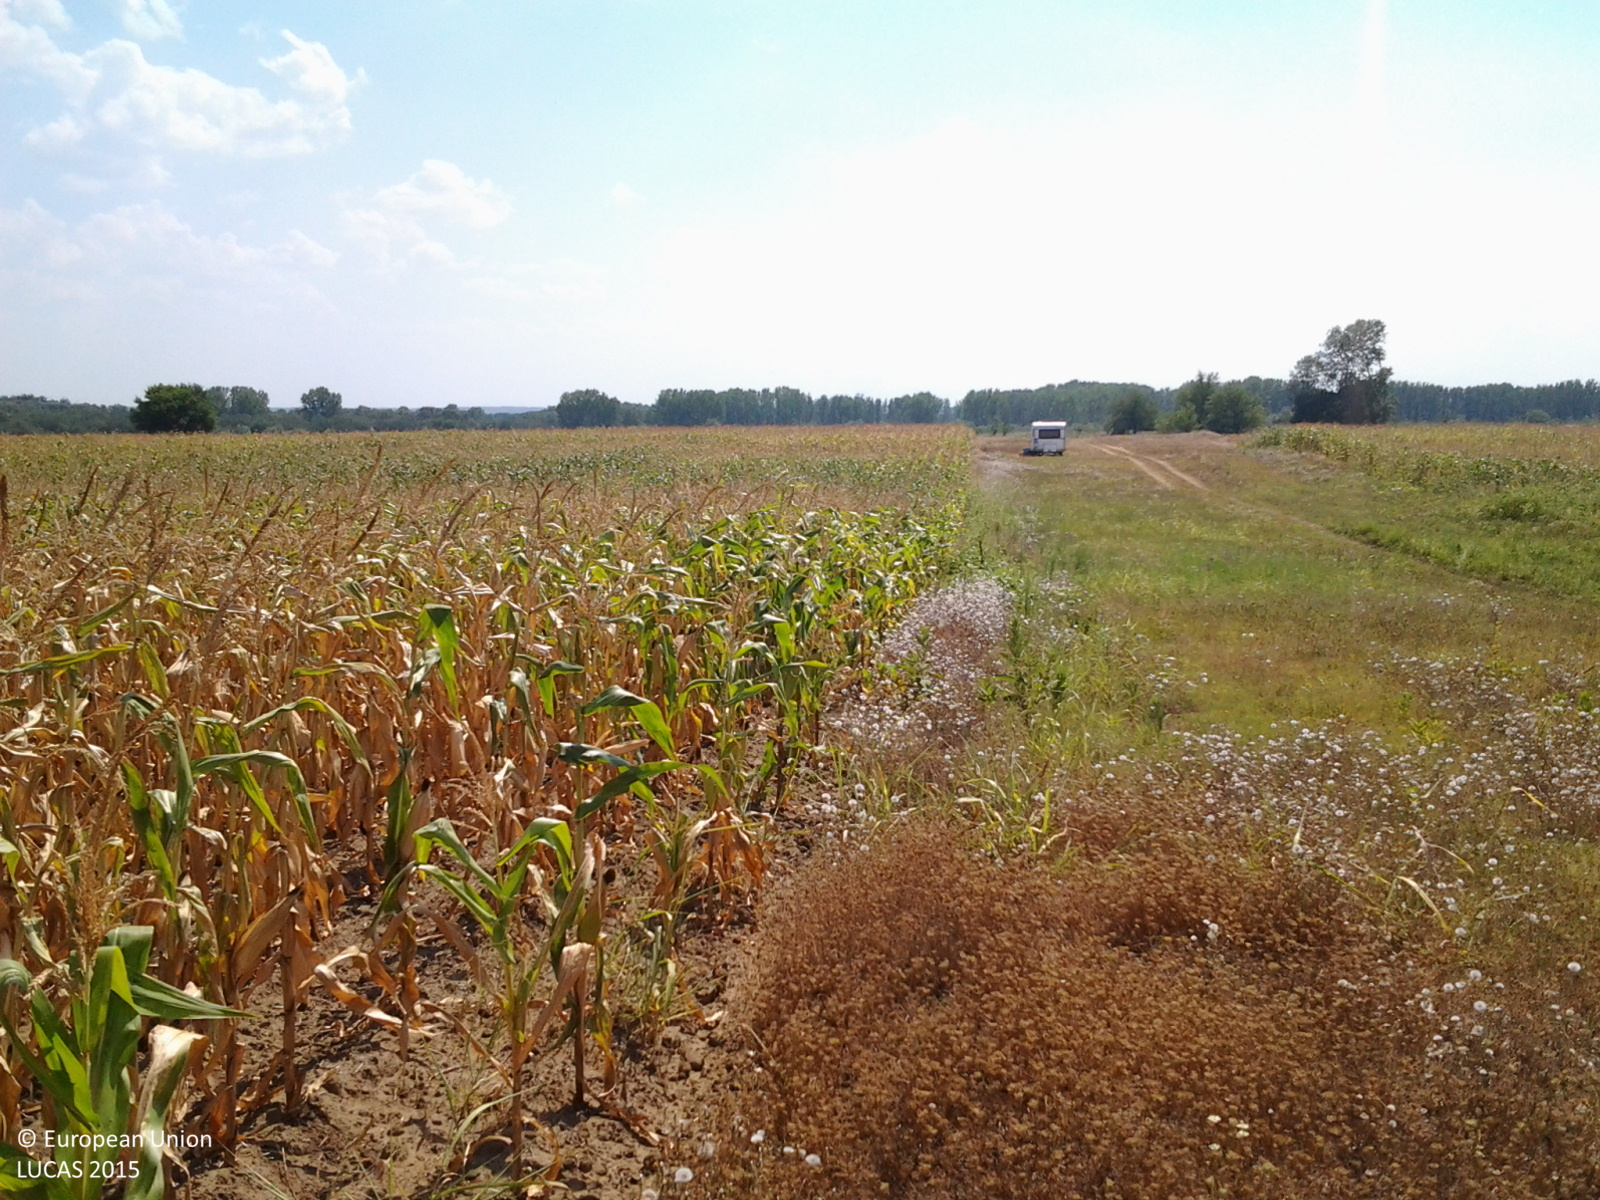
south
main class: Cropland
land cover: Maize
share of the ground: > 75 %
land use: Agriculture (excluding fallow land and kitchen gardens)
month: August
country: RO
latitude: 43.8345
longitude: 23.0366
